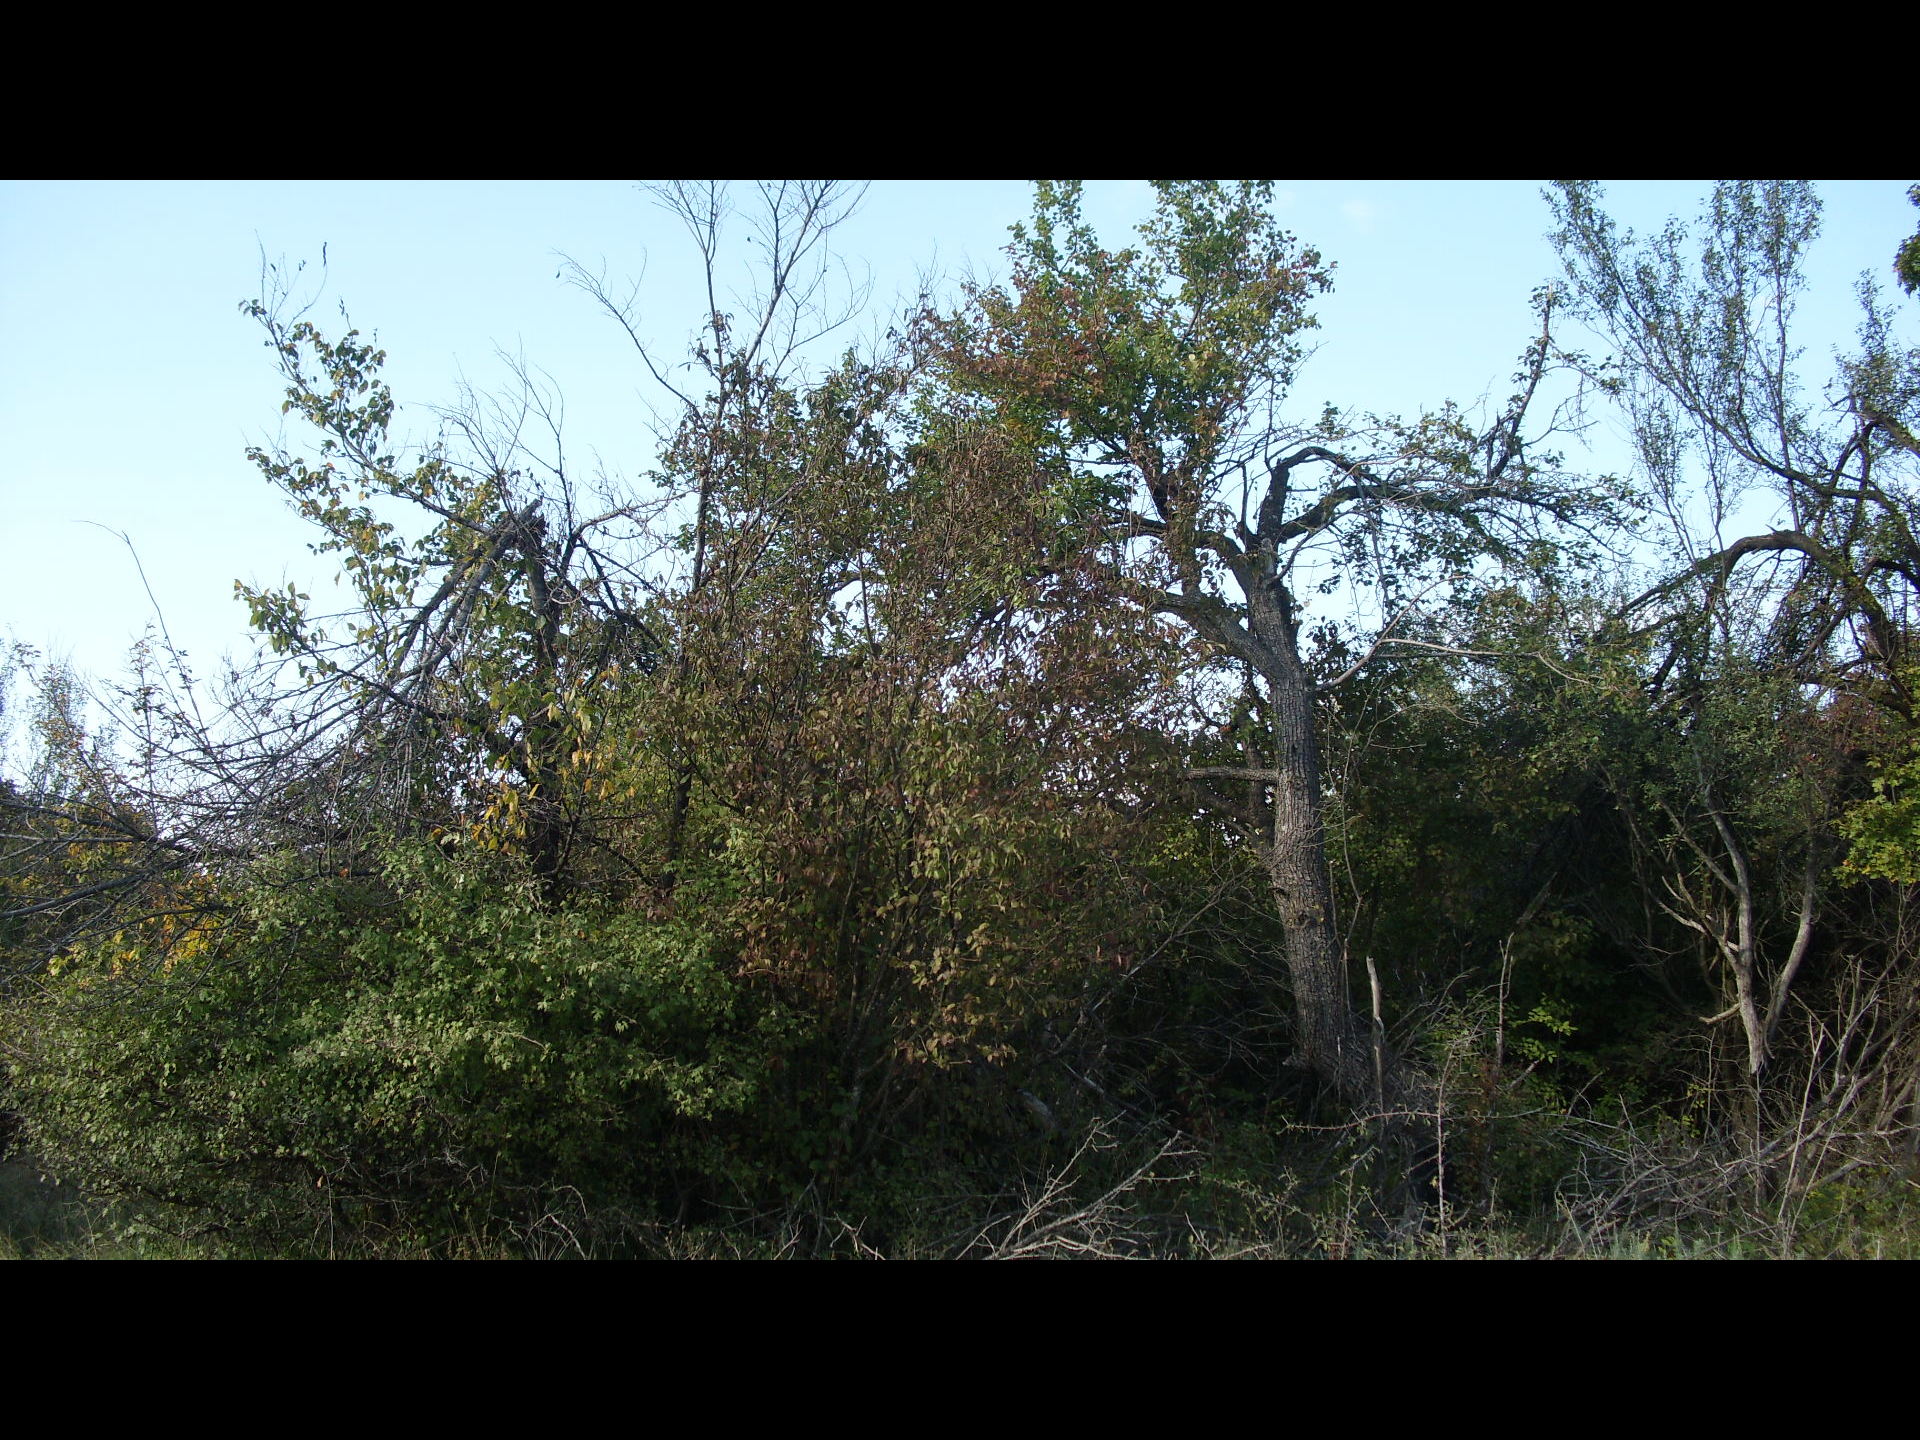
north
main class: Shrubland
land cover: Shrubland with sparse tree cover
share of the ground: > 75 %
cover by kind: shrubs 75 %, herbaceous plants 20 %, broadleaved forest trees 5 %
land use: Semi-natural and natural areas not in use
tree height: < 5 m
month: October
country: BG
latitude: 43.8428
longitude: 22.3827
